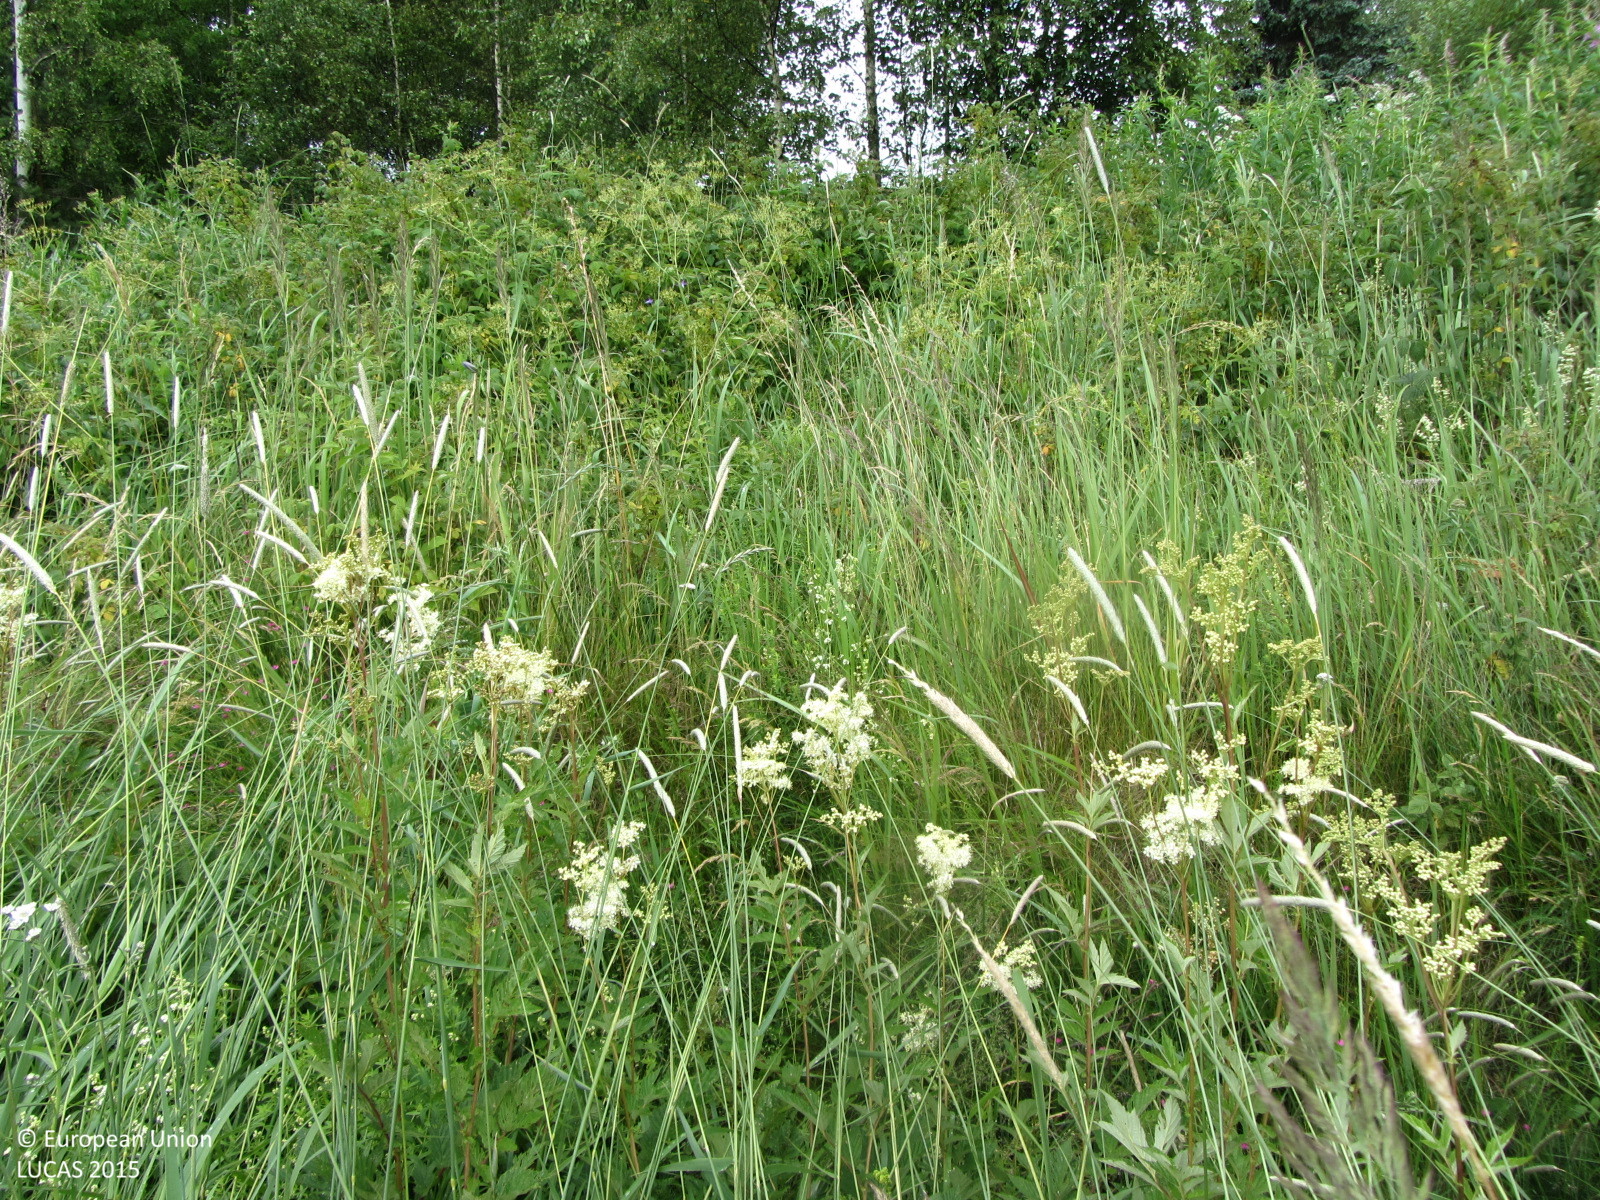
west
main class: Cropland
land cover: Common wheat
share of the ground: > 75 %
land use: Agriculture (excluding fallow land and kitchen gardens)
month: July
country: FI
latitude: 60.0583
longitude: 24.0566
